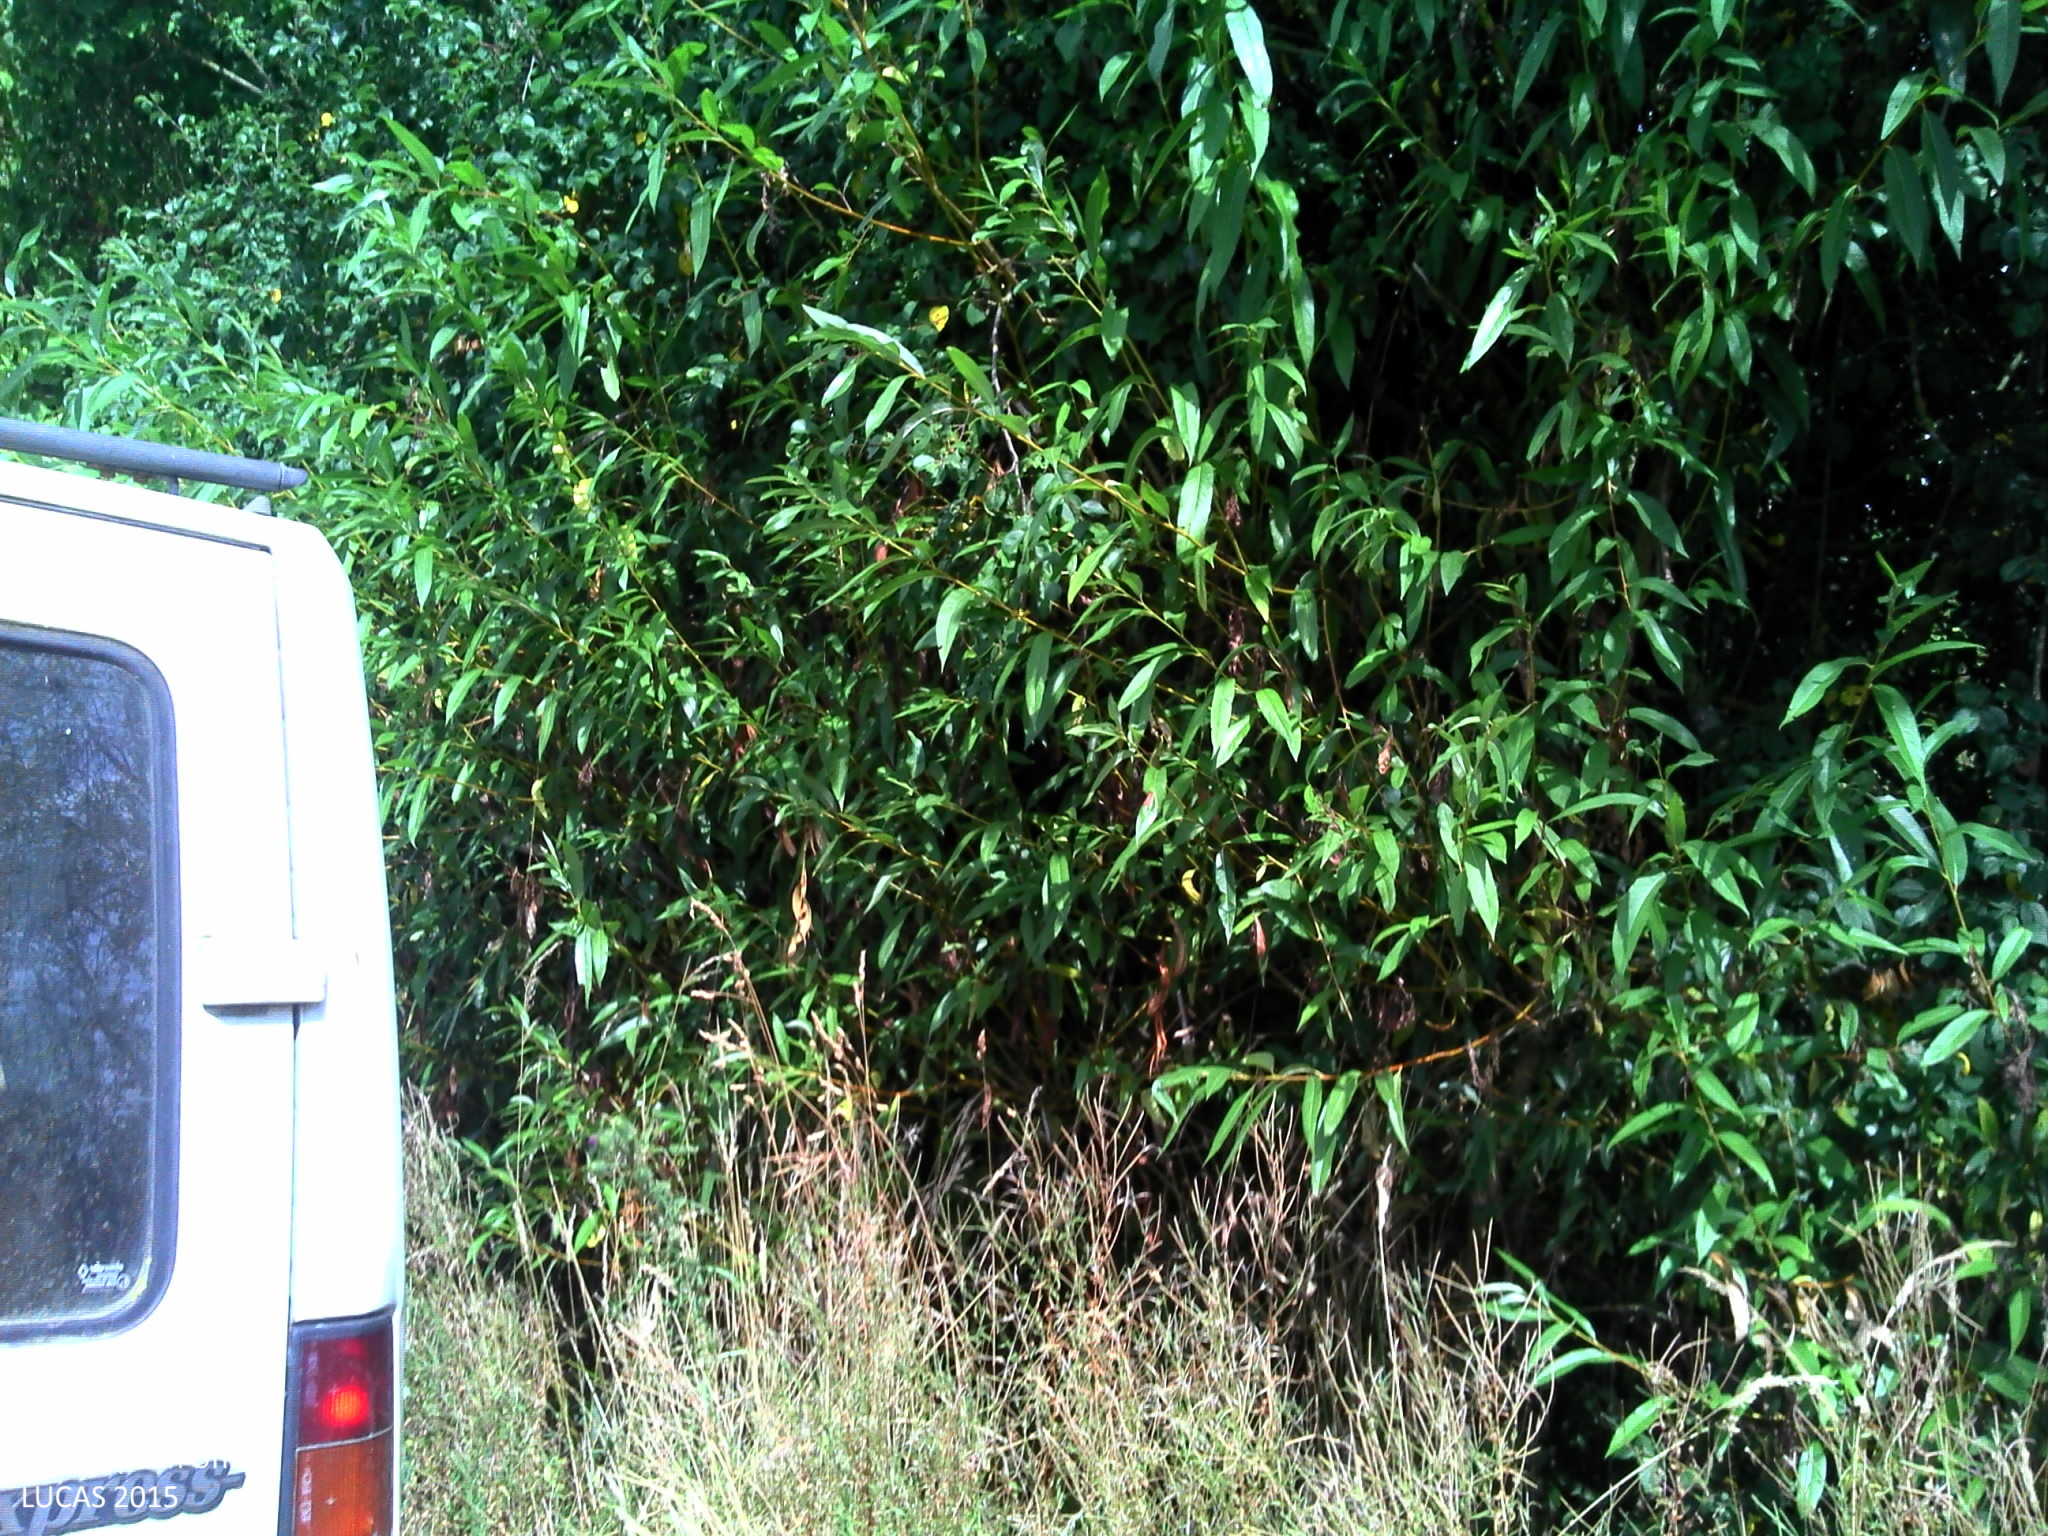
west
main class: Woodland
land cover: Broadleaved woodland
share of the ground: 50 - 75 %
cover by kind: broadleaved forest trees 45 %, herbaceous plants 40 %, shrubs 15 %
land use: Semi-natural and natural areas not in use
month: July
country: FR
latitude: 47.8493
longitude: 0.7179
